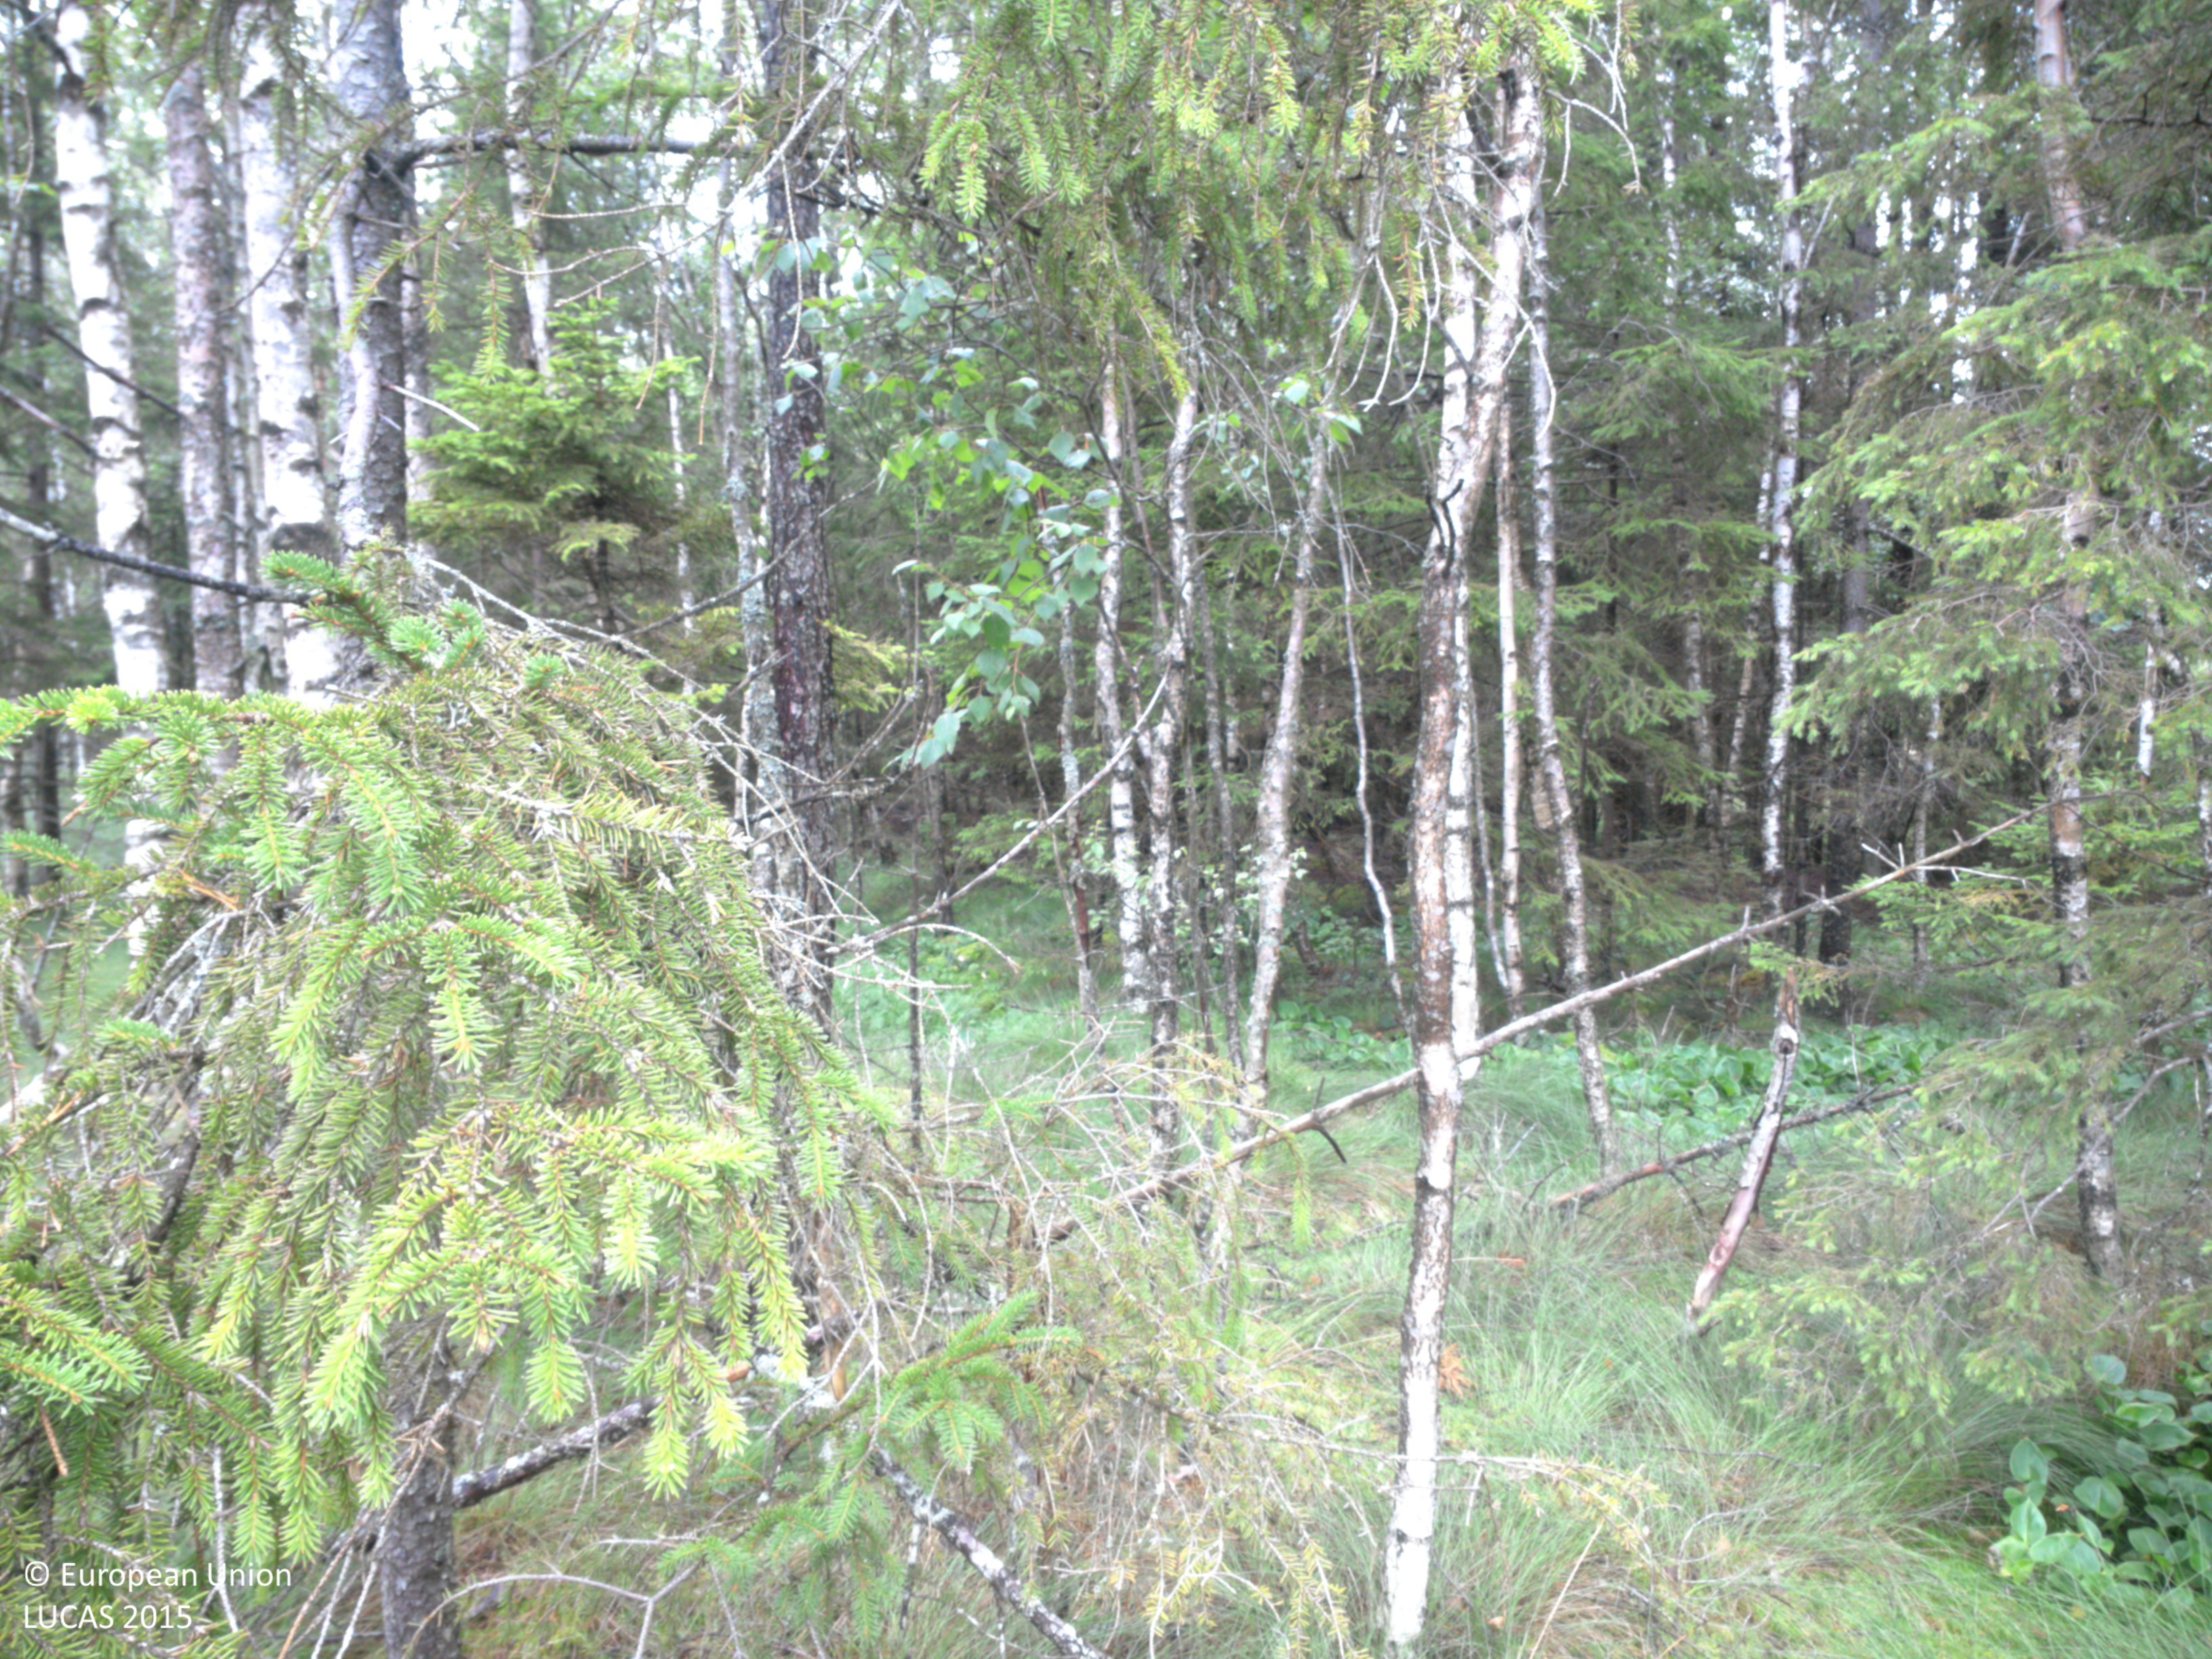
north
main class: Woodland
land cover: Pine dominated mixed woodland
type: boreal forest
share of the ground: 50 - 75 %
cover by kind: lichens and mosses 50 %, coniferous forest trees 30 %, broadleaved forest trees 20 %
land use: Semi-natural and natural areas not in use
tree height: < 5 m
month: July
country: SE
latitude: 58.6183
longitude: 12.0101
